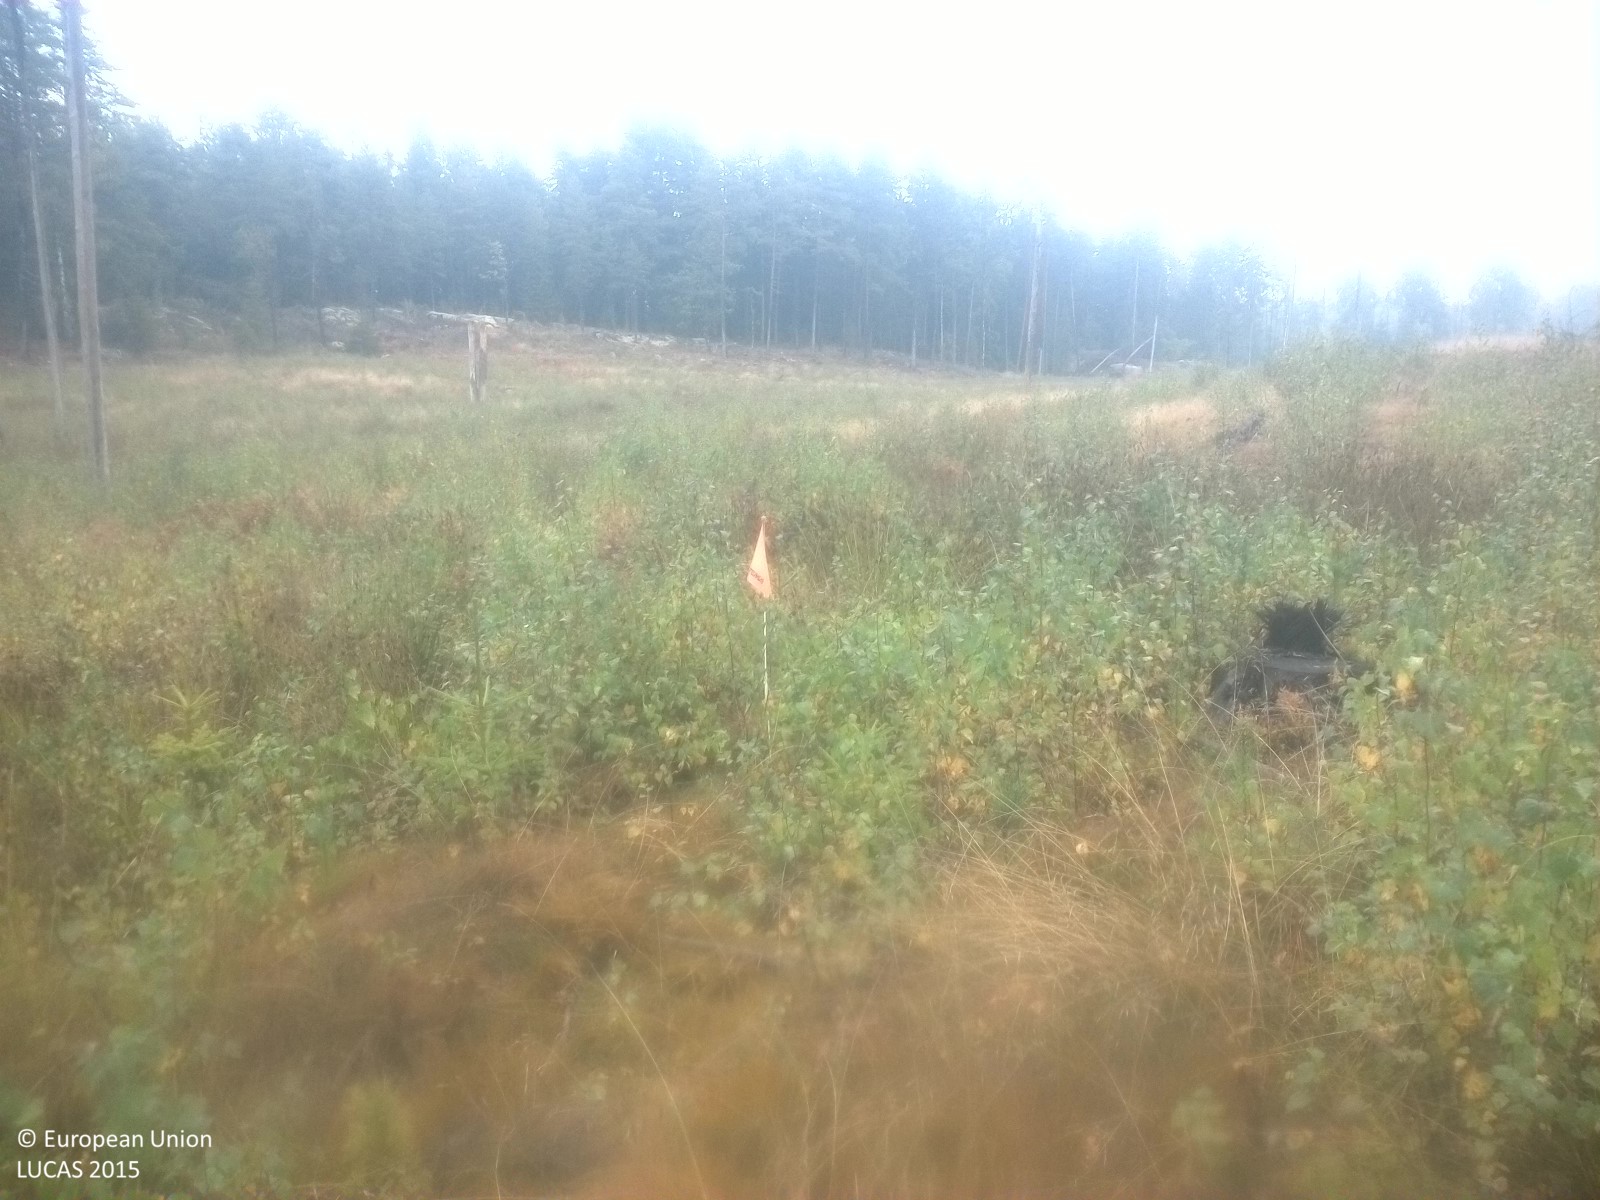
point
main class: Woodland
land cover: Broadleaved woodland
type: boreal forest
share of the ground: 50 - 75 %
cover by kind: broadleaved forest trees 55 %, herbaceous plants 35 %, coniferous forest trees 5 %, lichens and mosses 5 %
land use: Forestry
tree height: < 5 m
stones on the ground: 10 - 25 %
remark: Clear cut
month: September
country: SE
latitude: 58.5197
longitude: 16.7441
